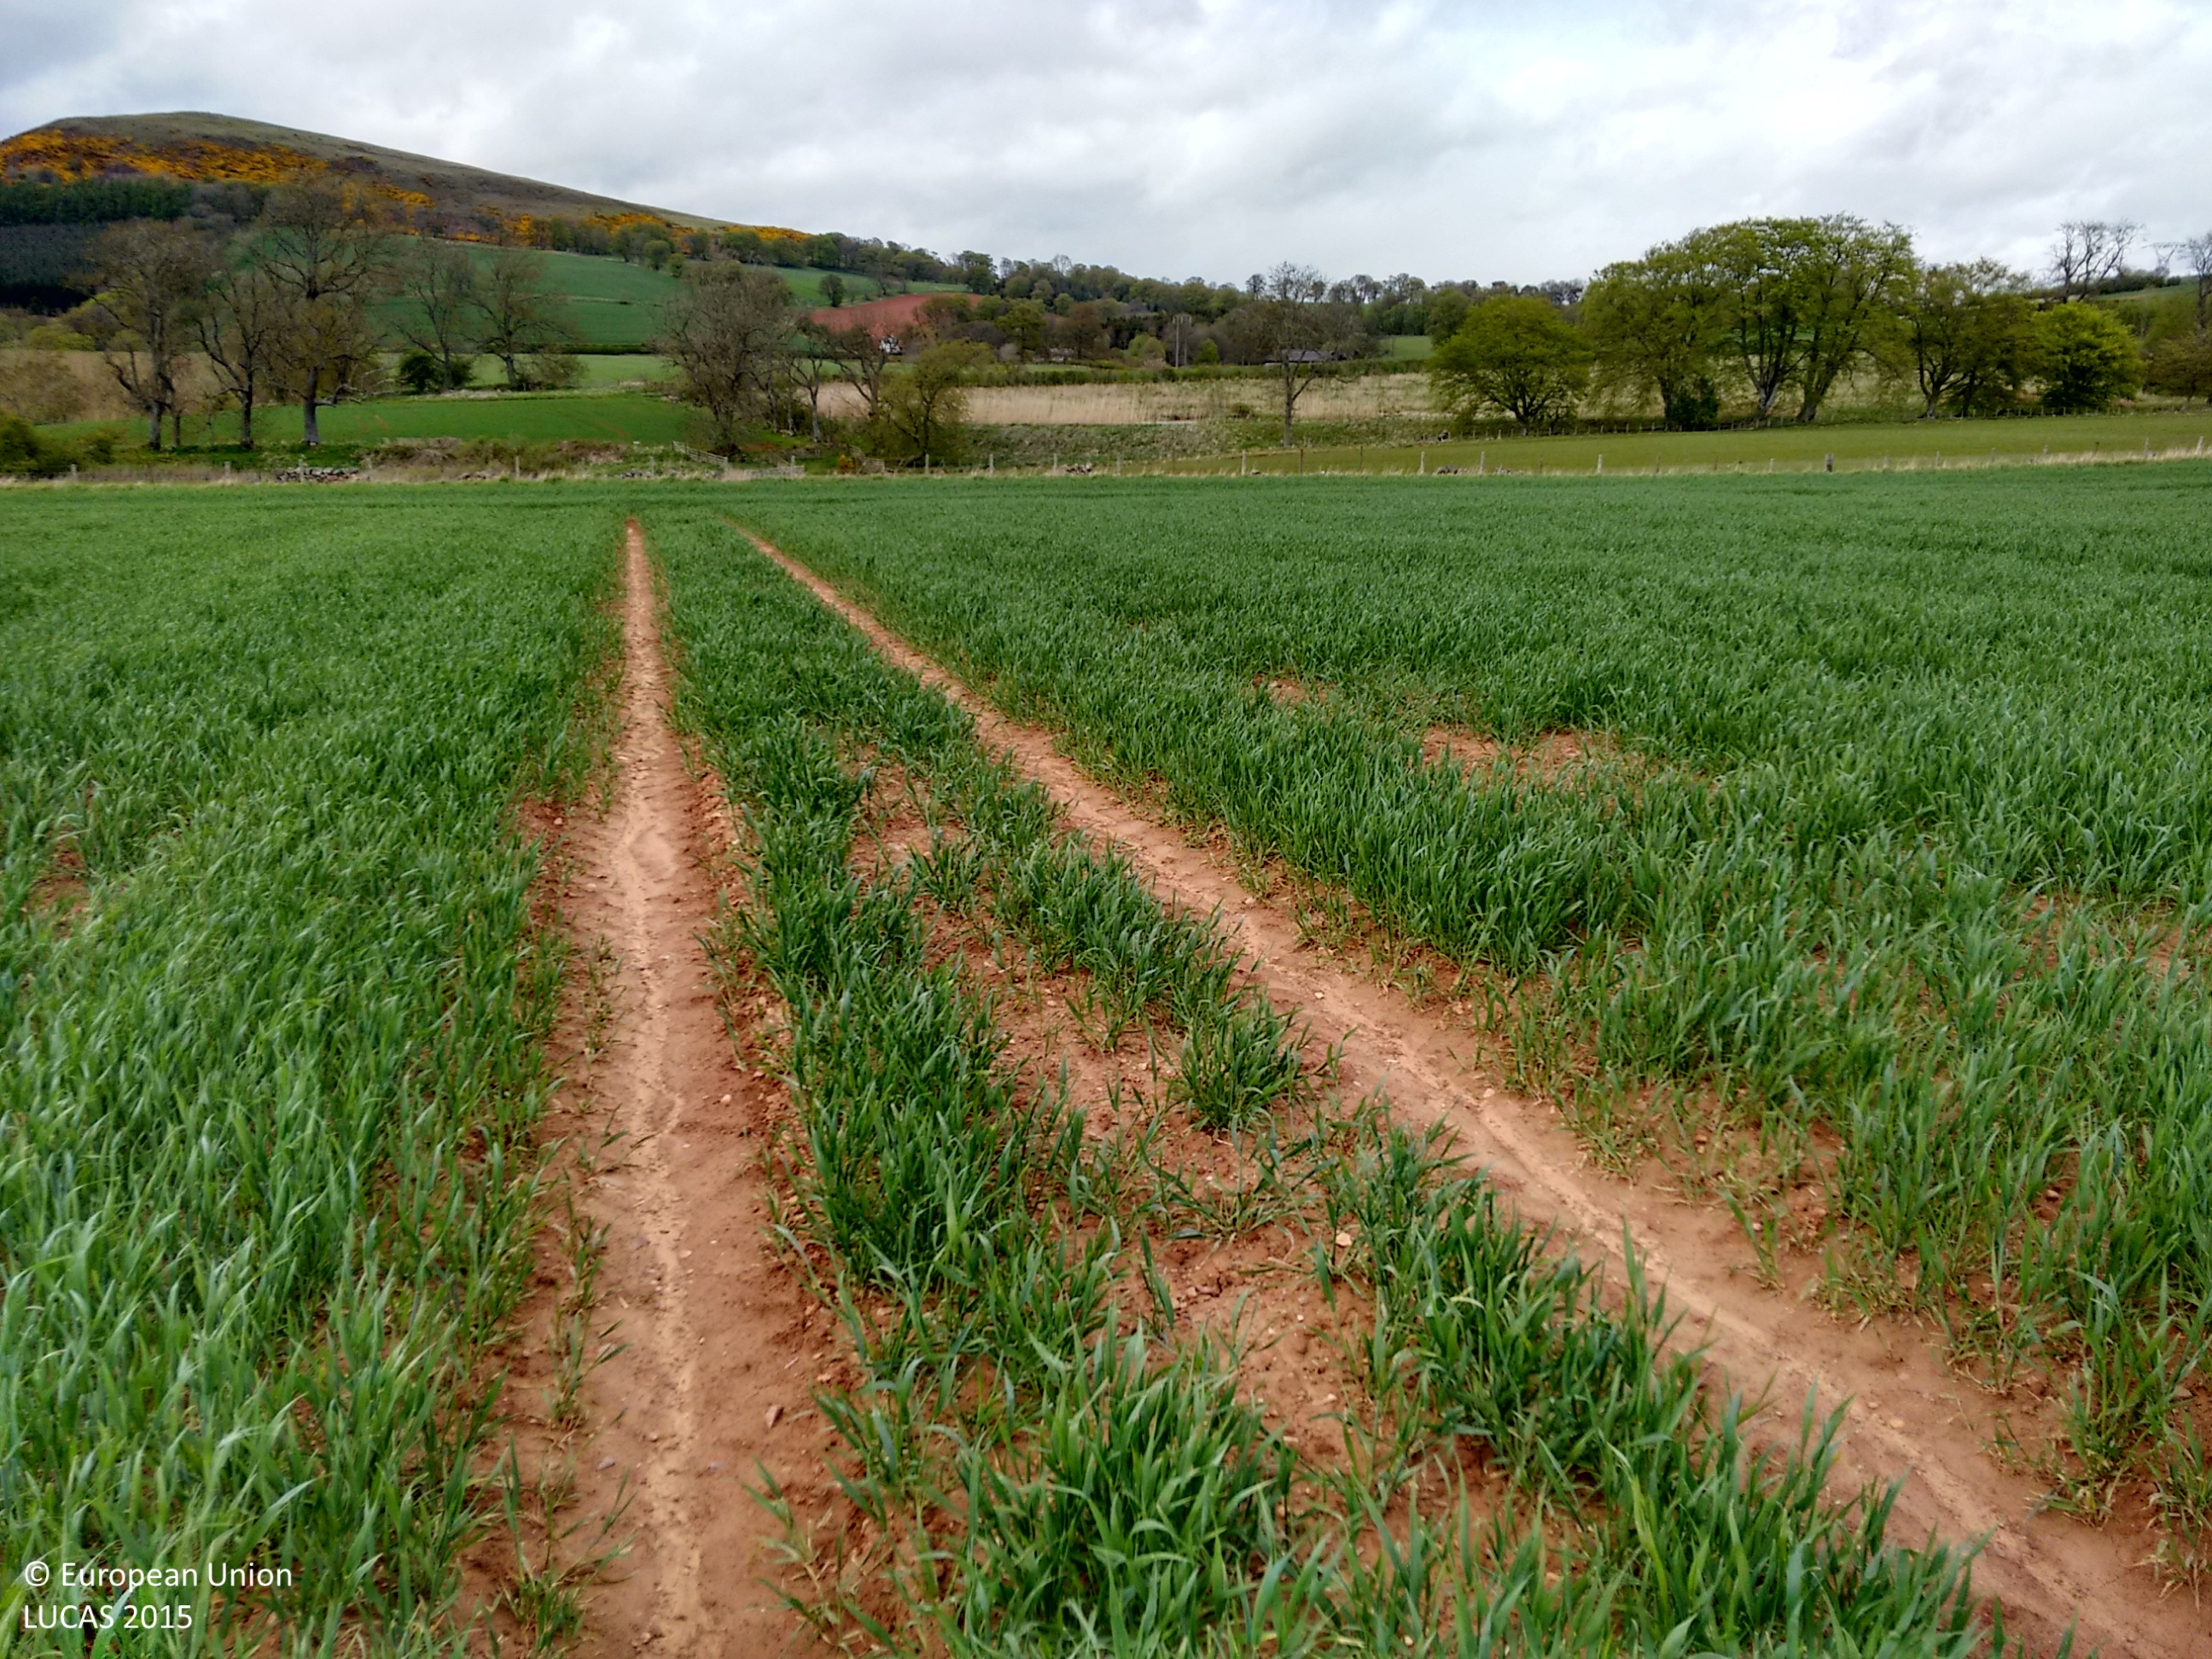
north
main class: Cropland
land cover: Oats
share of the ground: 25 - 50 %
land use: Agriculture (excluding fallow land and kitchen gardens)
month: May
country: GB
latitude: 55.6129
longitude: -2.6530
